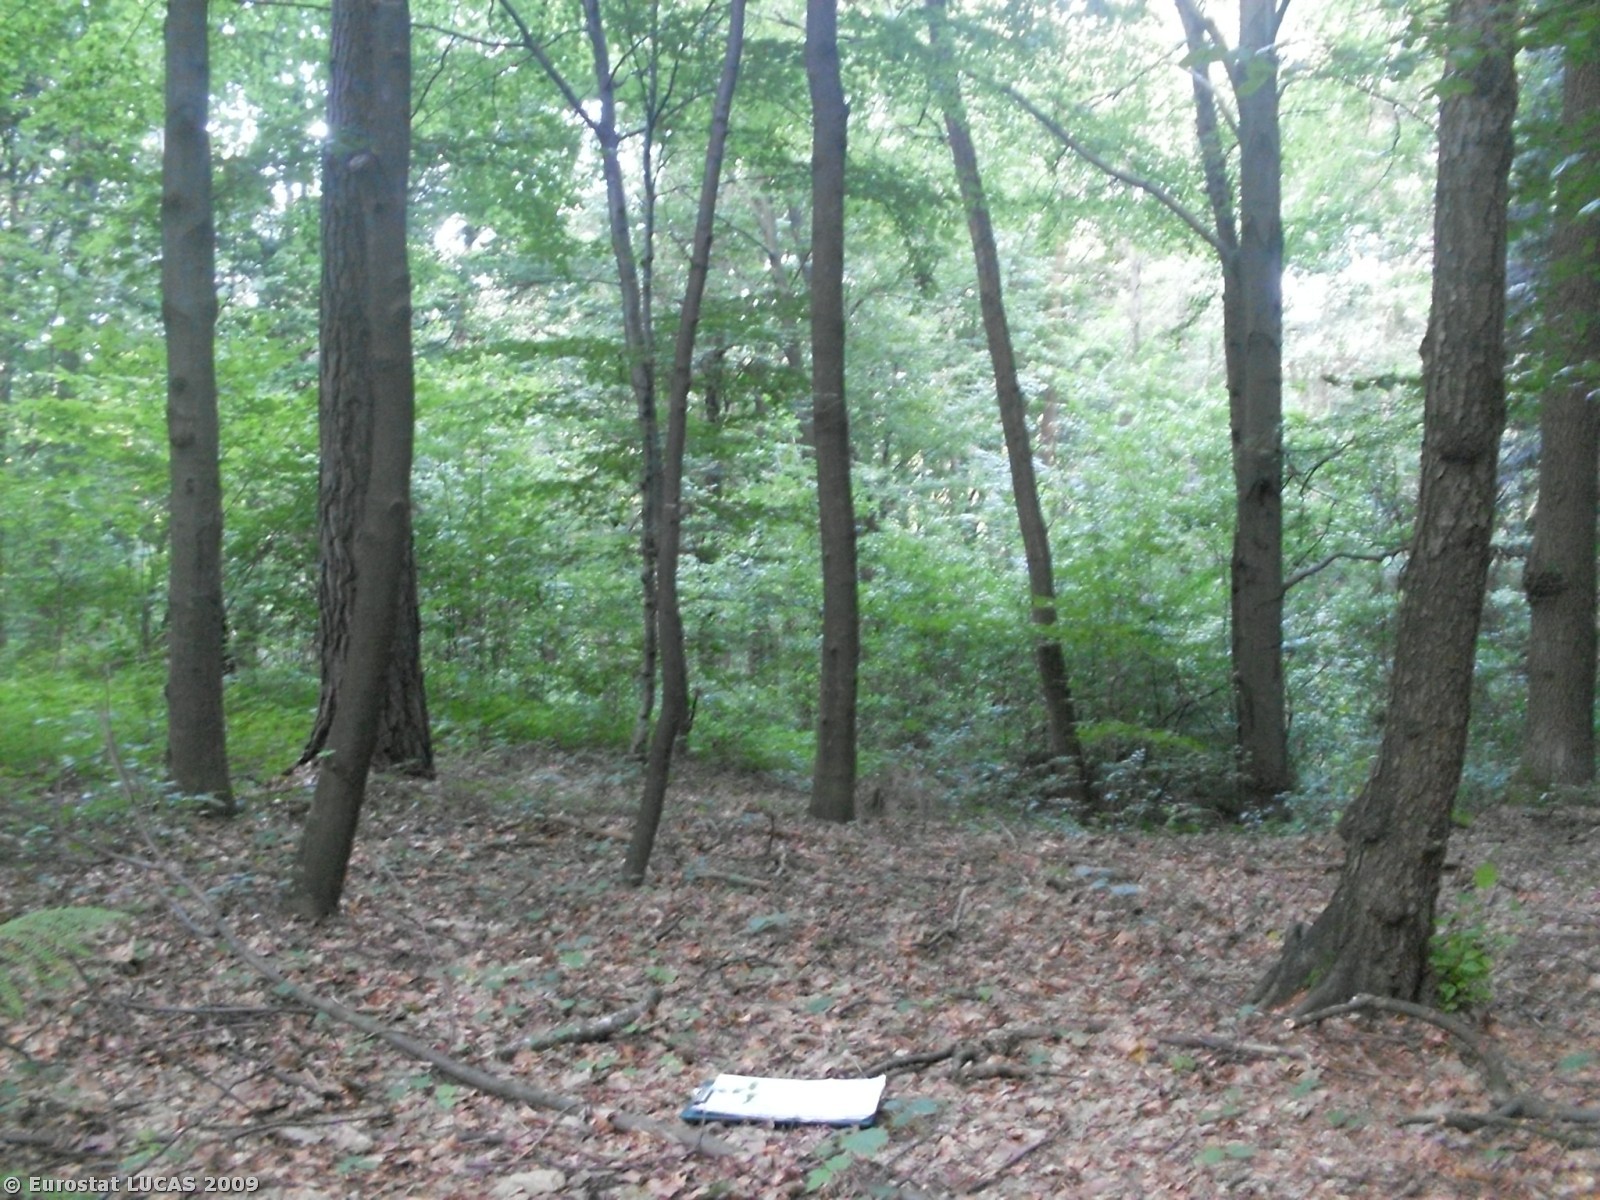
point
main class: Woodland
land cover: Broadleaved woodland
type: mesophytic deciduous forest
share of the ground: > 75 %
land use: Forestry
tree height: > 5 m
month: August
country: PL
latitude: 49.9182
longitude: 20.6660
